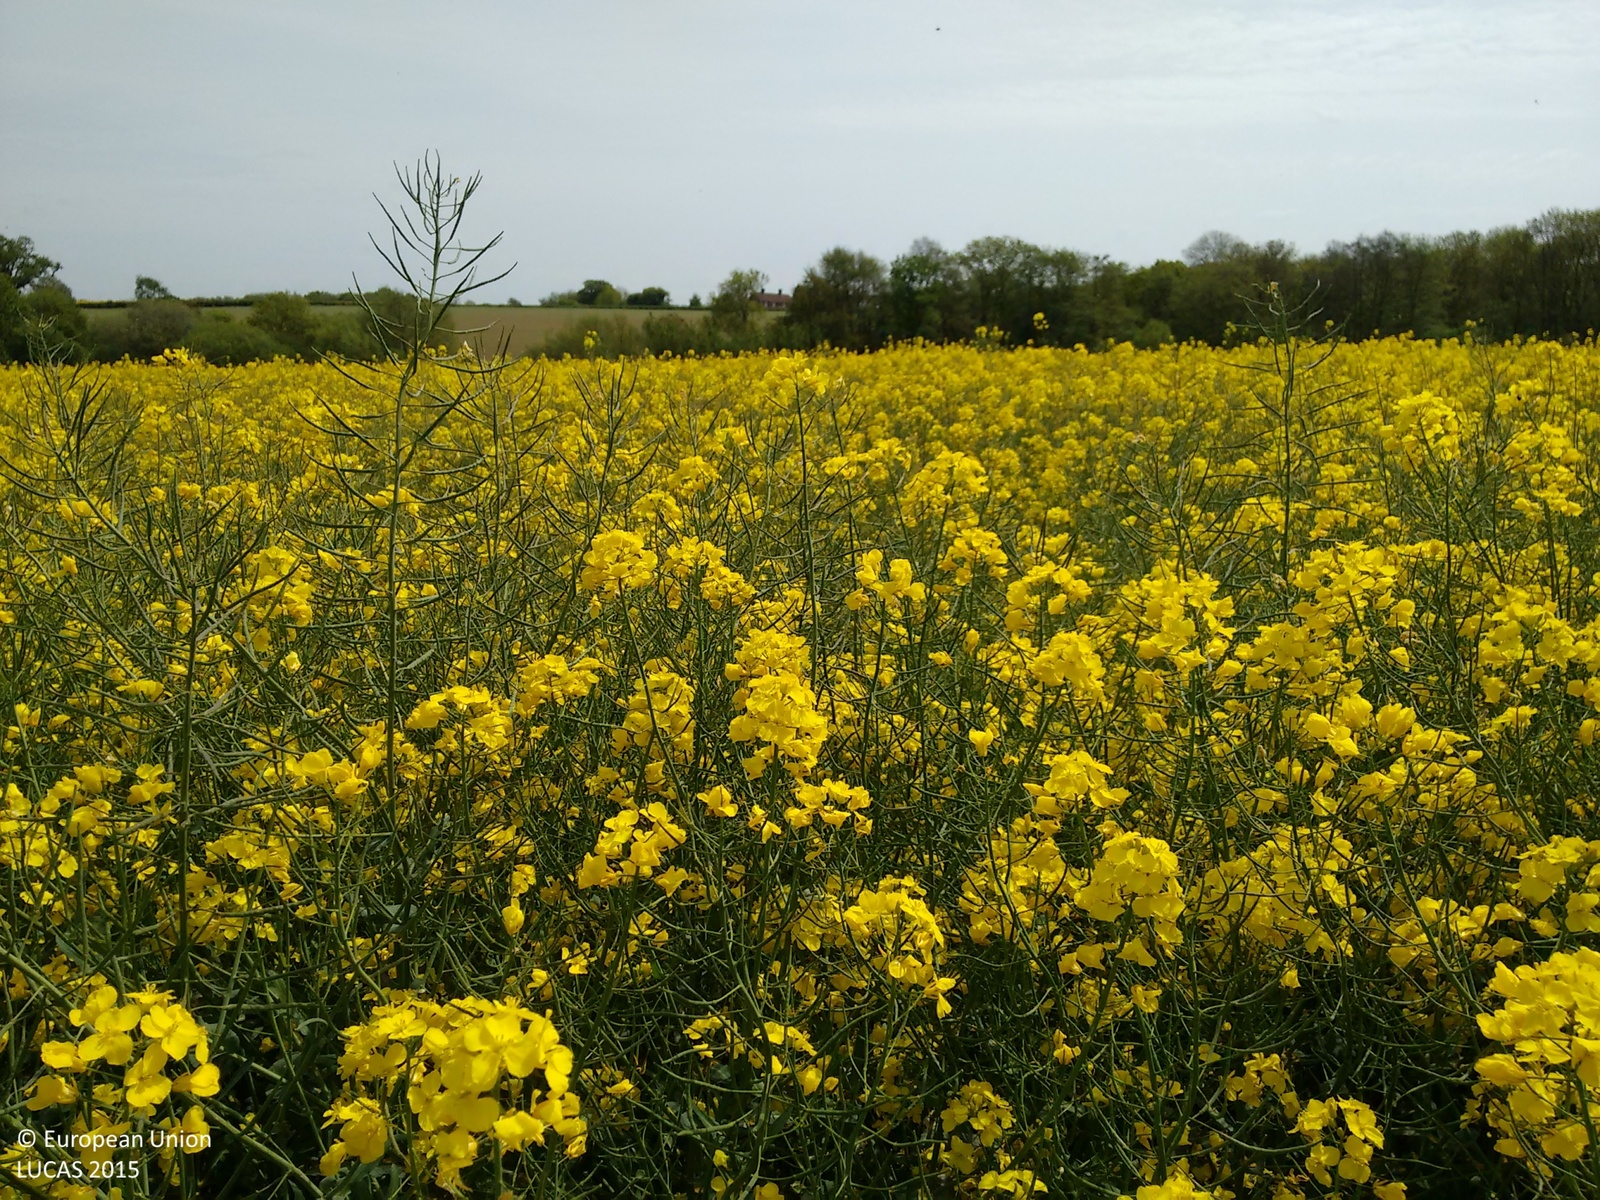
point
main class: Cropland
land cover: Rape and turnip rape
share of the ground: > 75 %
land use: Agriculture (excluding fallow land and kitchen gardens)
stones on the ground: < 10 %
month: May
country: GB
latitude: 51.1836
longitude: 0.3135
